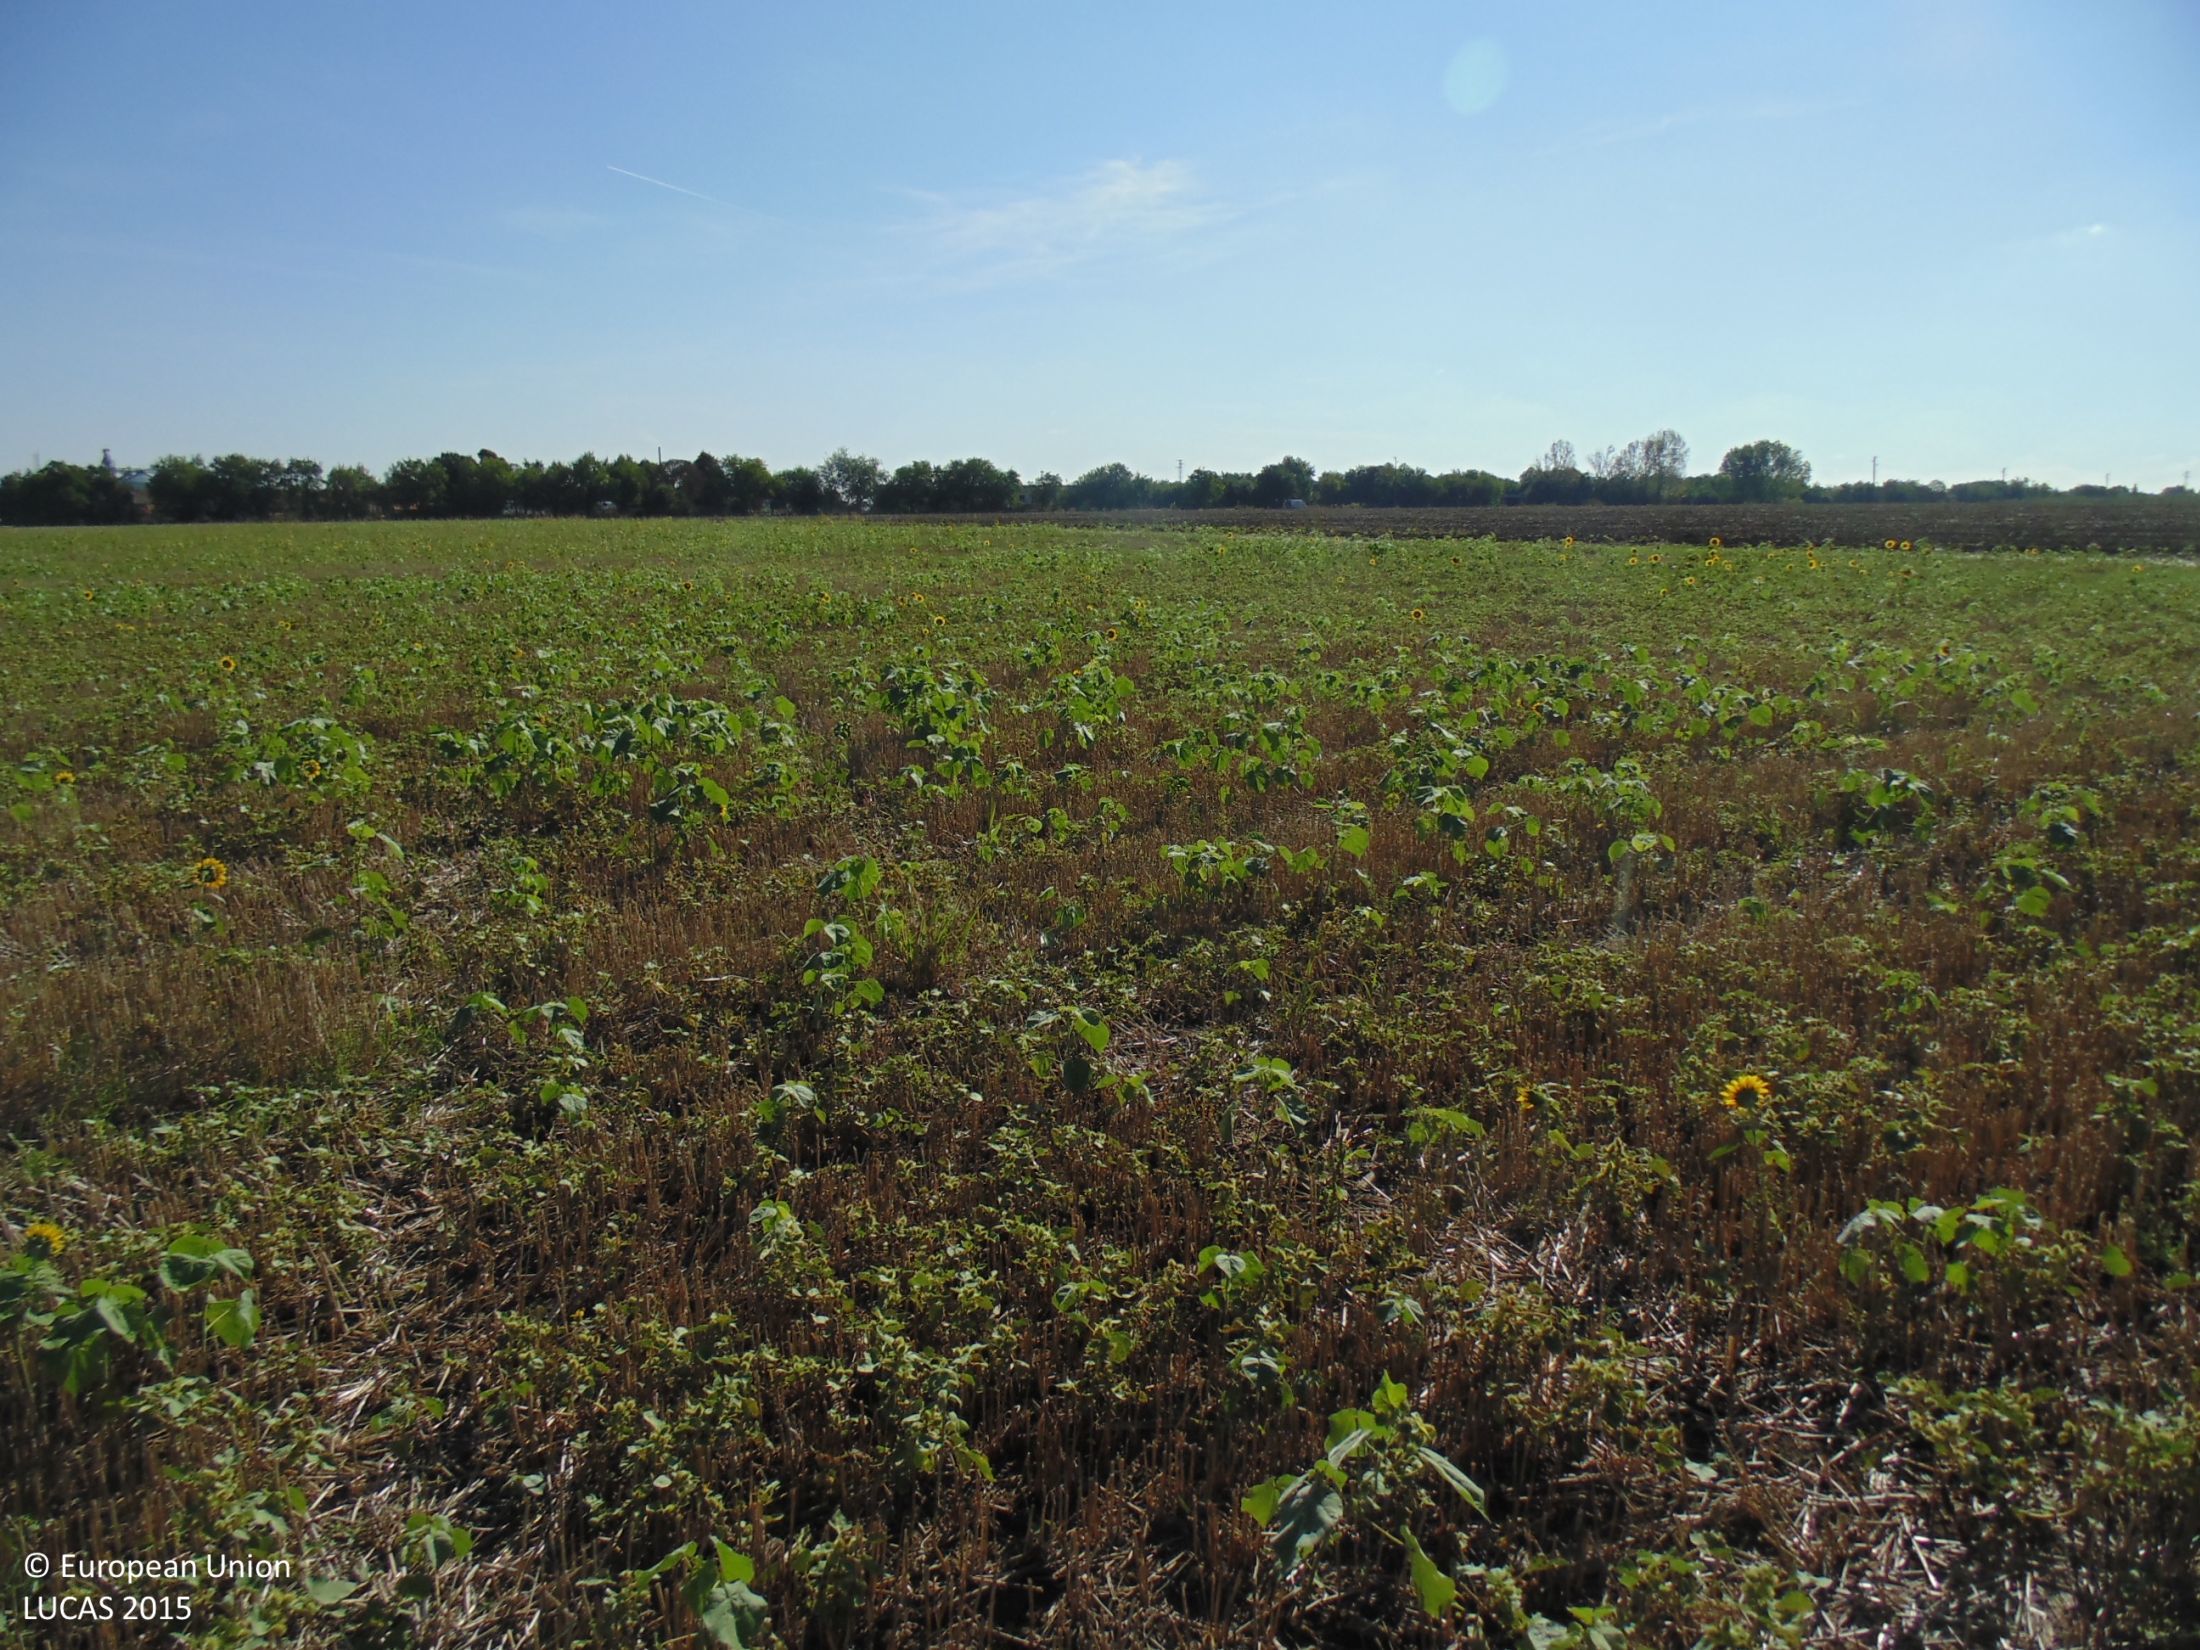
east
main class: Cropland
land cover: Common wheat
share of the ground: 10 - 25 %
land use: Agriculture (excluding fallow land and kitchen gardens)
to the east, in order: Common wheat; Grass margins; Rape and turnip rape
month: September
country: BG
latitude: 44.0380
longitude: 27.0078
